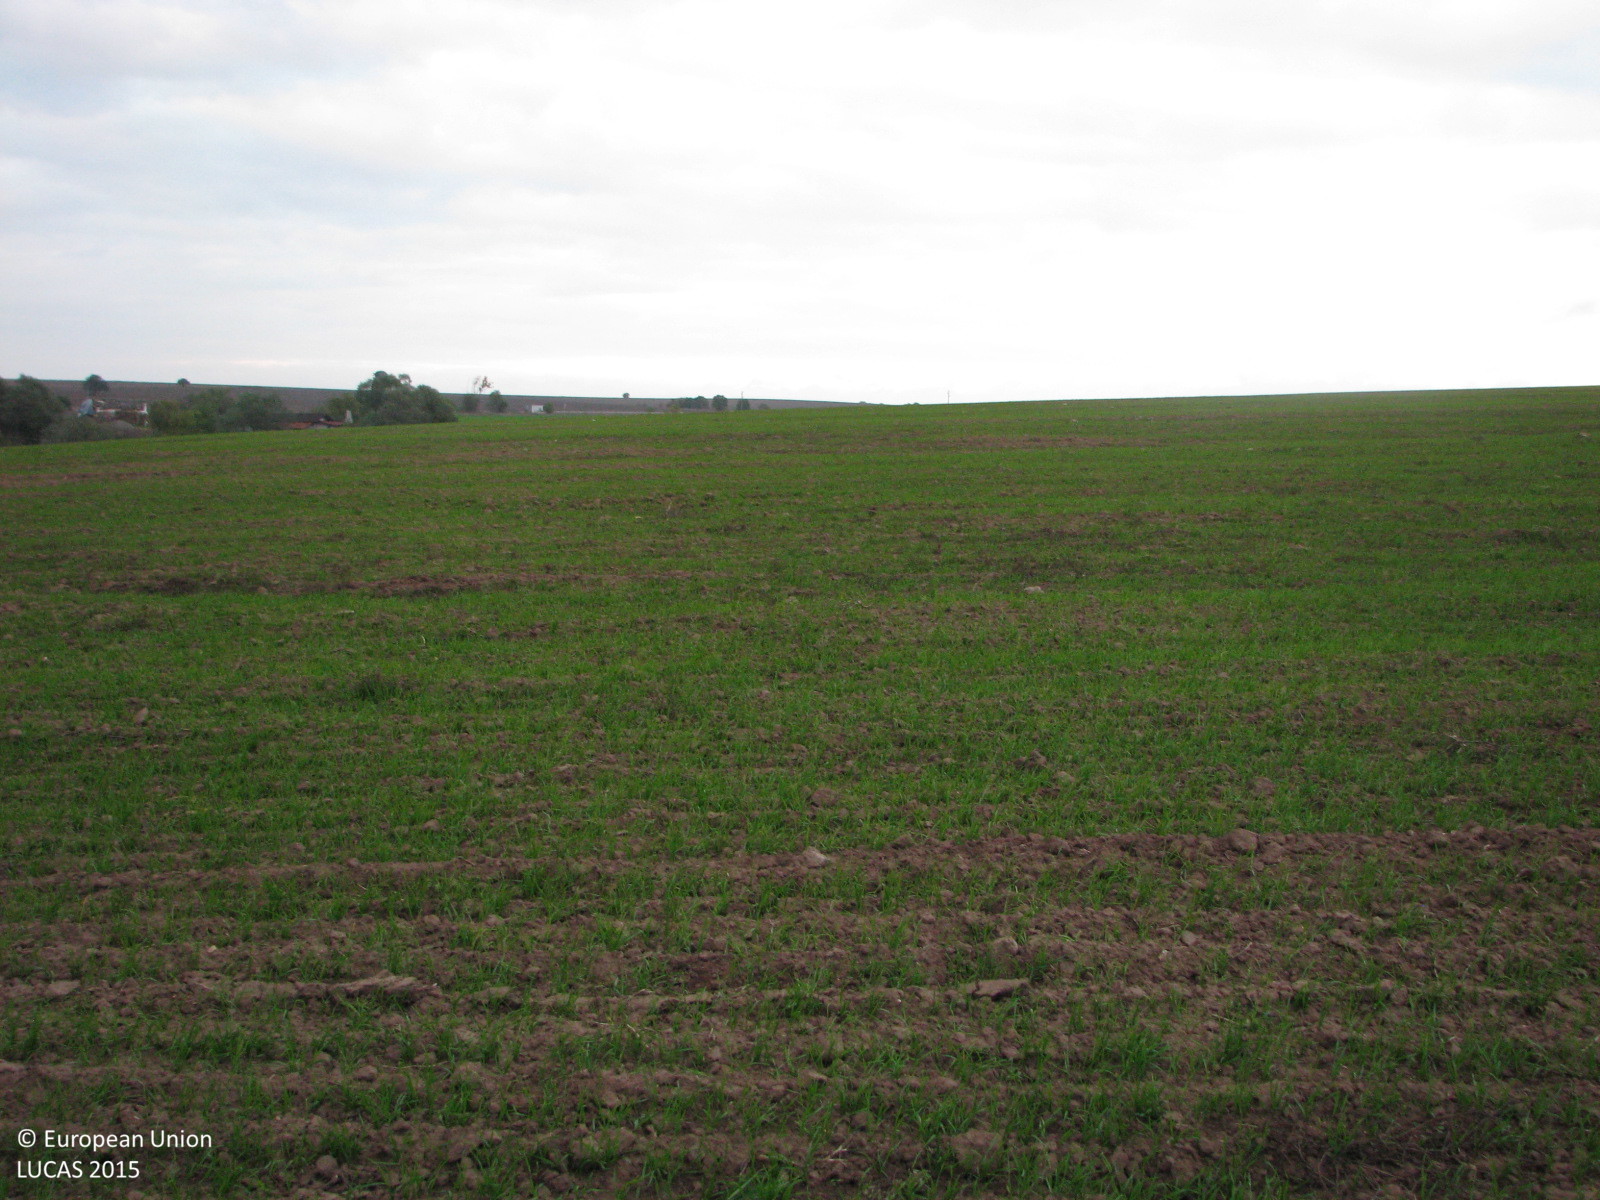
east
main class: Cropland
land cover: Common wheat
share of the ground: 25 - 50 %
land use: Agriculture (excluding fallow land and kitchen gardens)
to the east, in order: Common wheat; Grassland without tree/shrub cover; Inland fresh water bodies
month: October
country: BG
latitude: 42.0921
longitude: 26.5428
